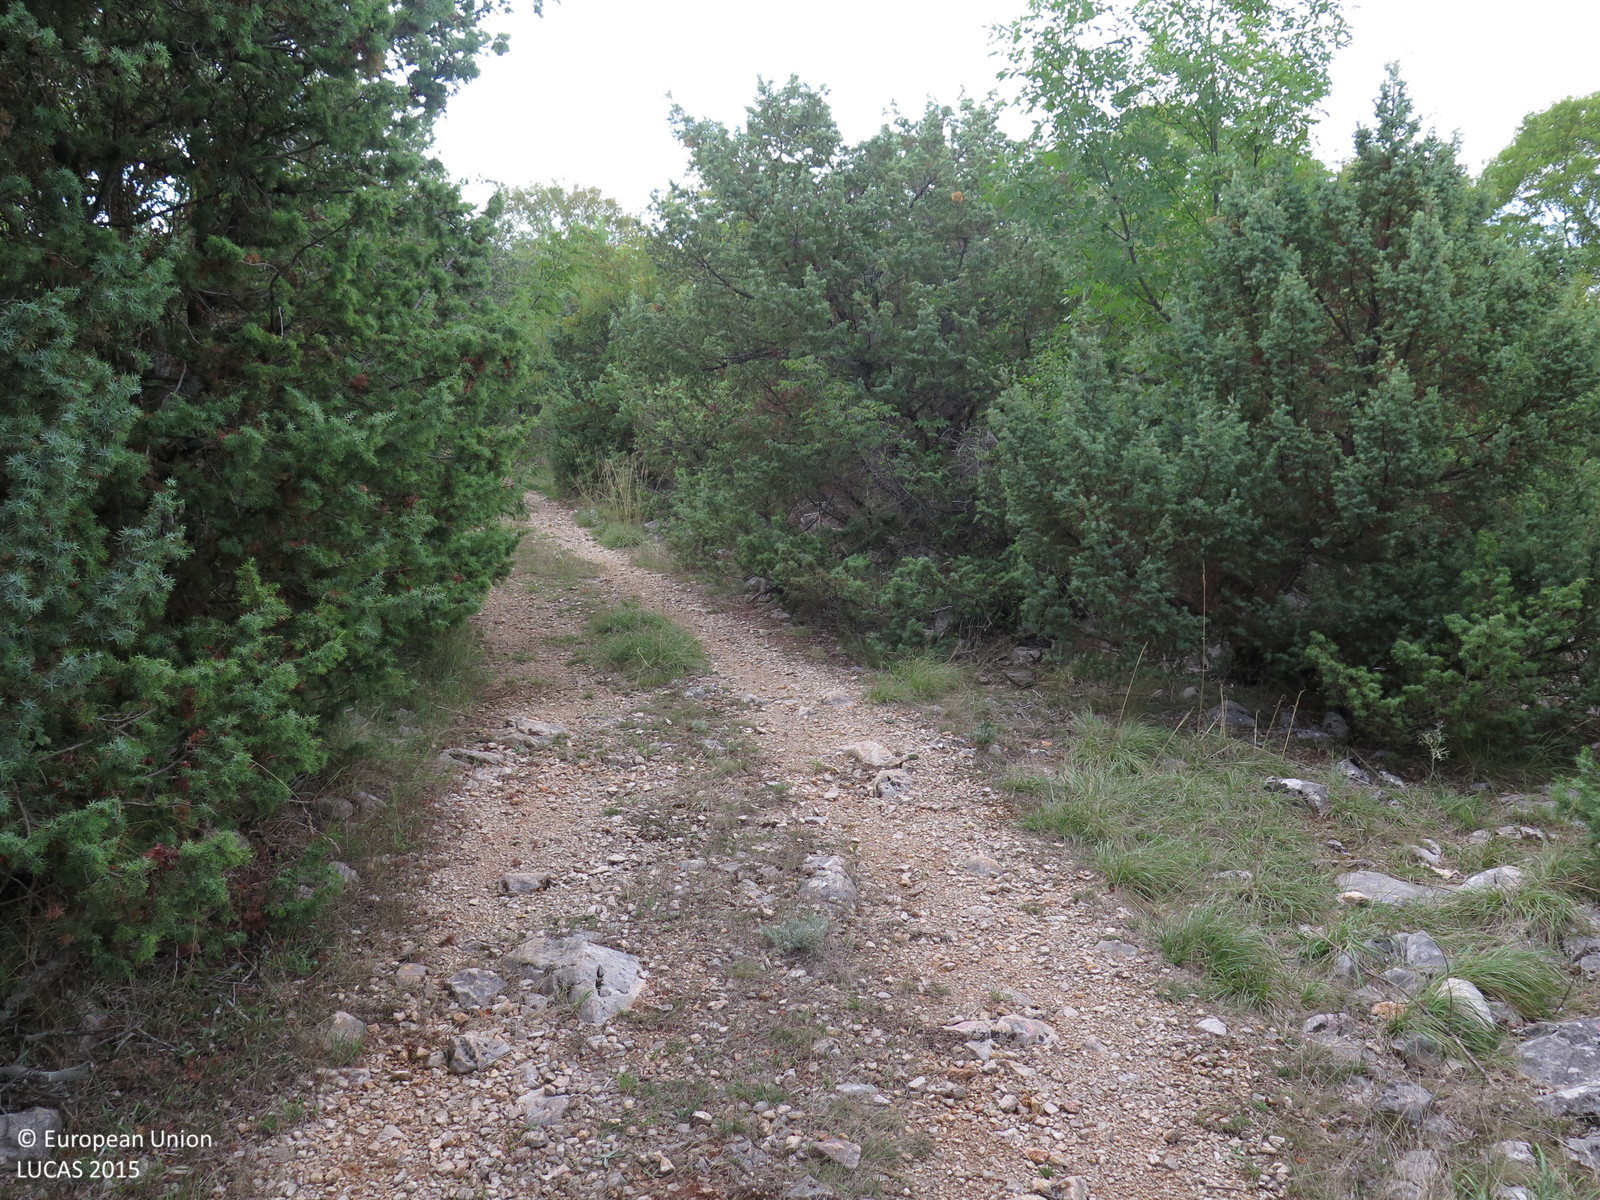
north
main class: Shrubland
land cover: Shrubland with sparse tree cover
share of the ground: > 75 %
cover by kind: shrubs 90 %, broadleaved forest trees 5 %, herbaceous plants 5 %
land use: Semi-natural and natural areas not in use
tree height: < 5 m
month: August
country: HR
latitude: 45.0599
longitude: 14.6296
